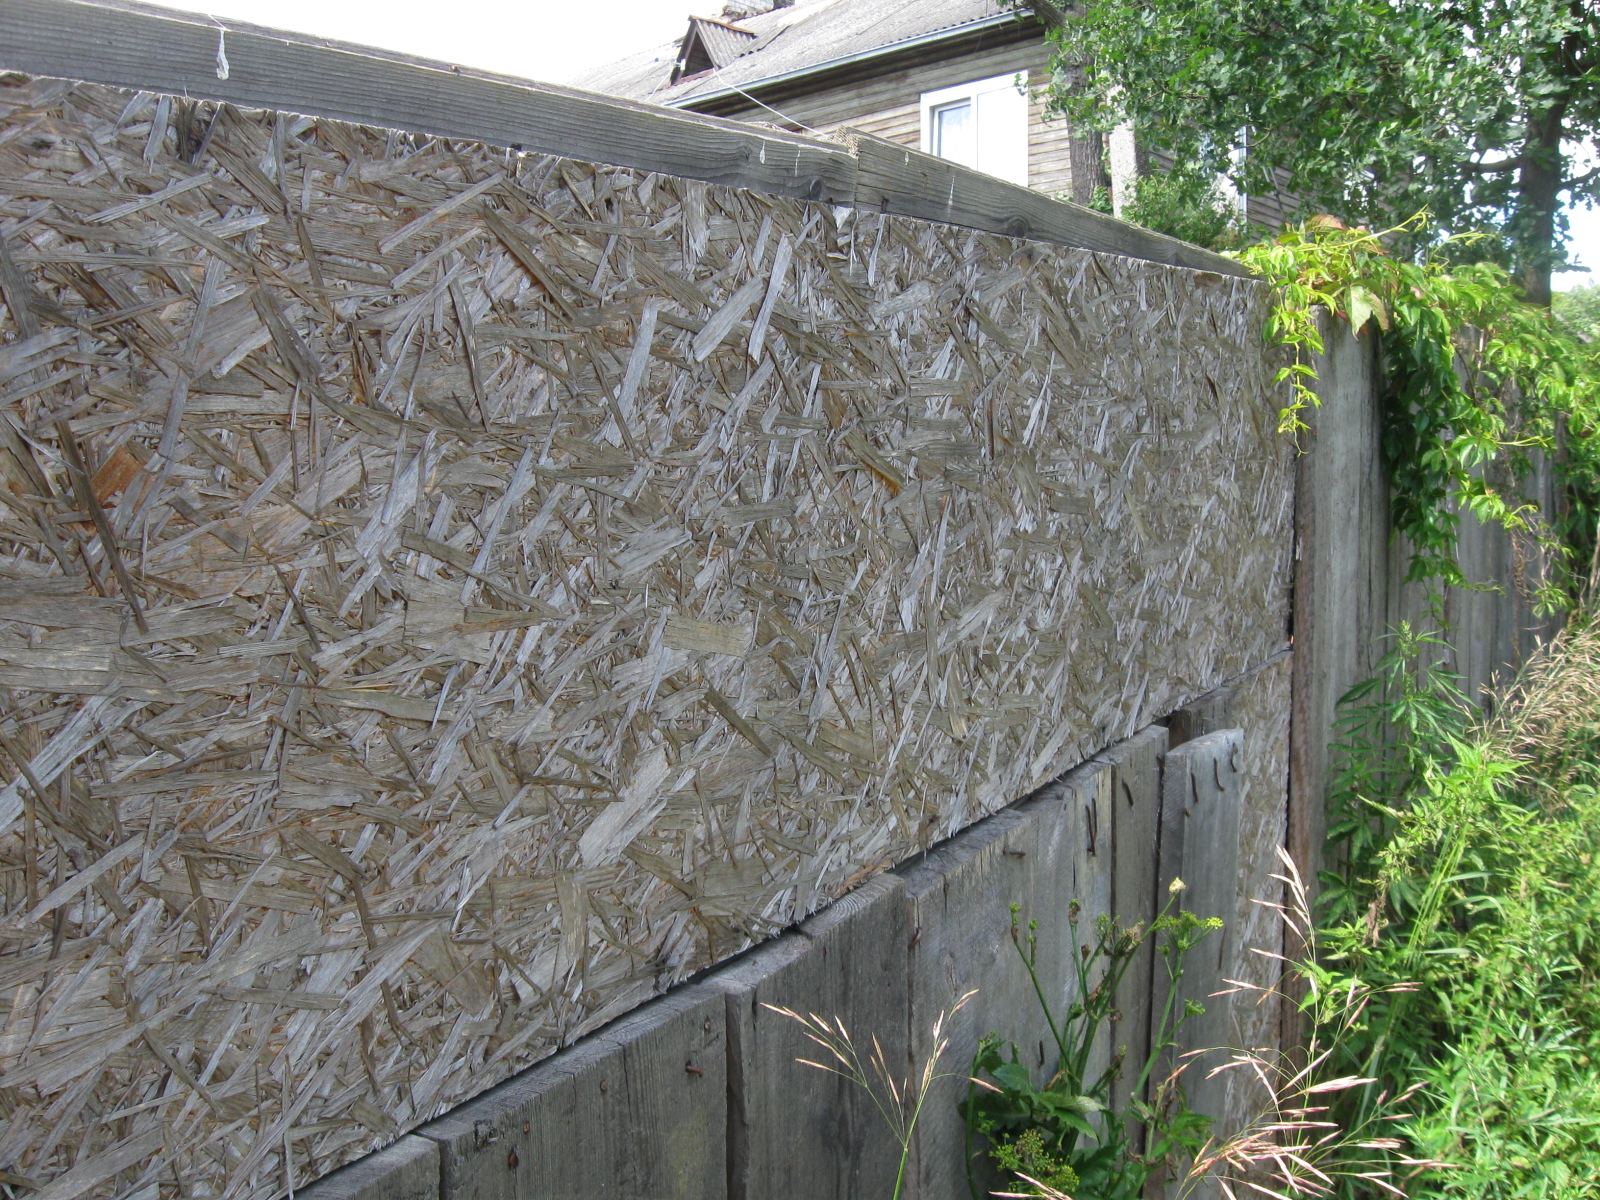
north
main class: Shrubland
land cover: Shrubland with sparse tree cover
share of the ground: > 75 %
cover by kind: herbaceous plants 45 %, shrubs 40 %, unconsolidated bare surface 10 %, broadleaved forest trees 5 %
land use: Semi-natural and natural areas not in use
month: July
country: LT
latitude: 54.8730
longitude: 23.9439
